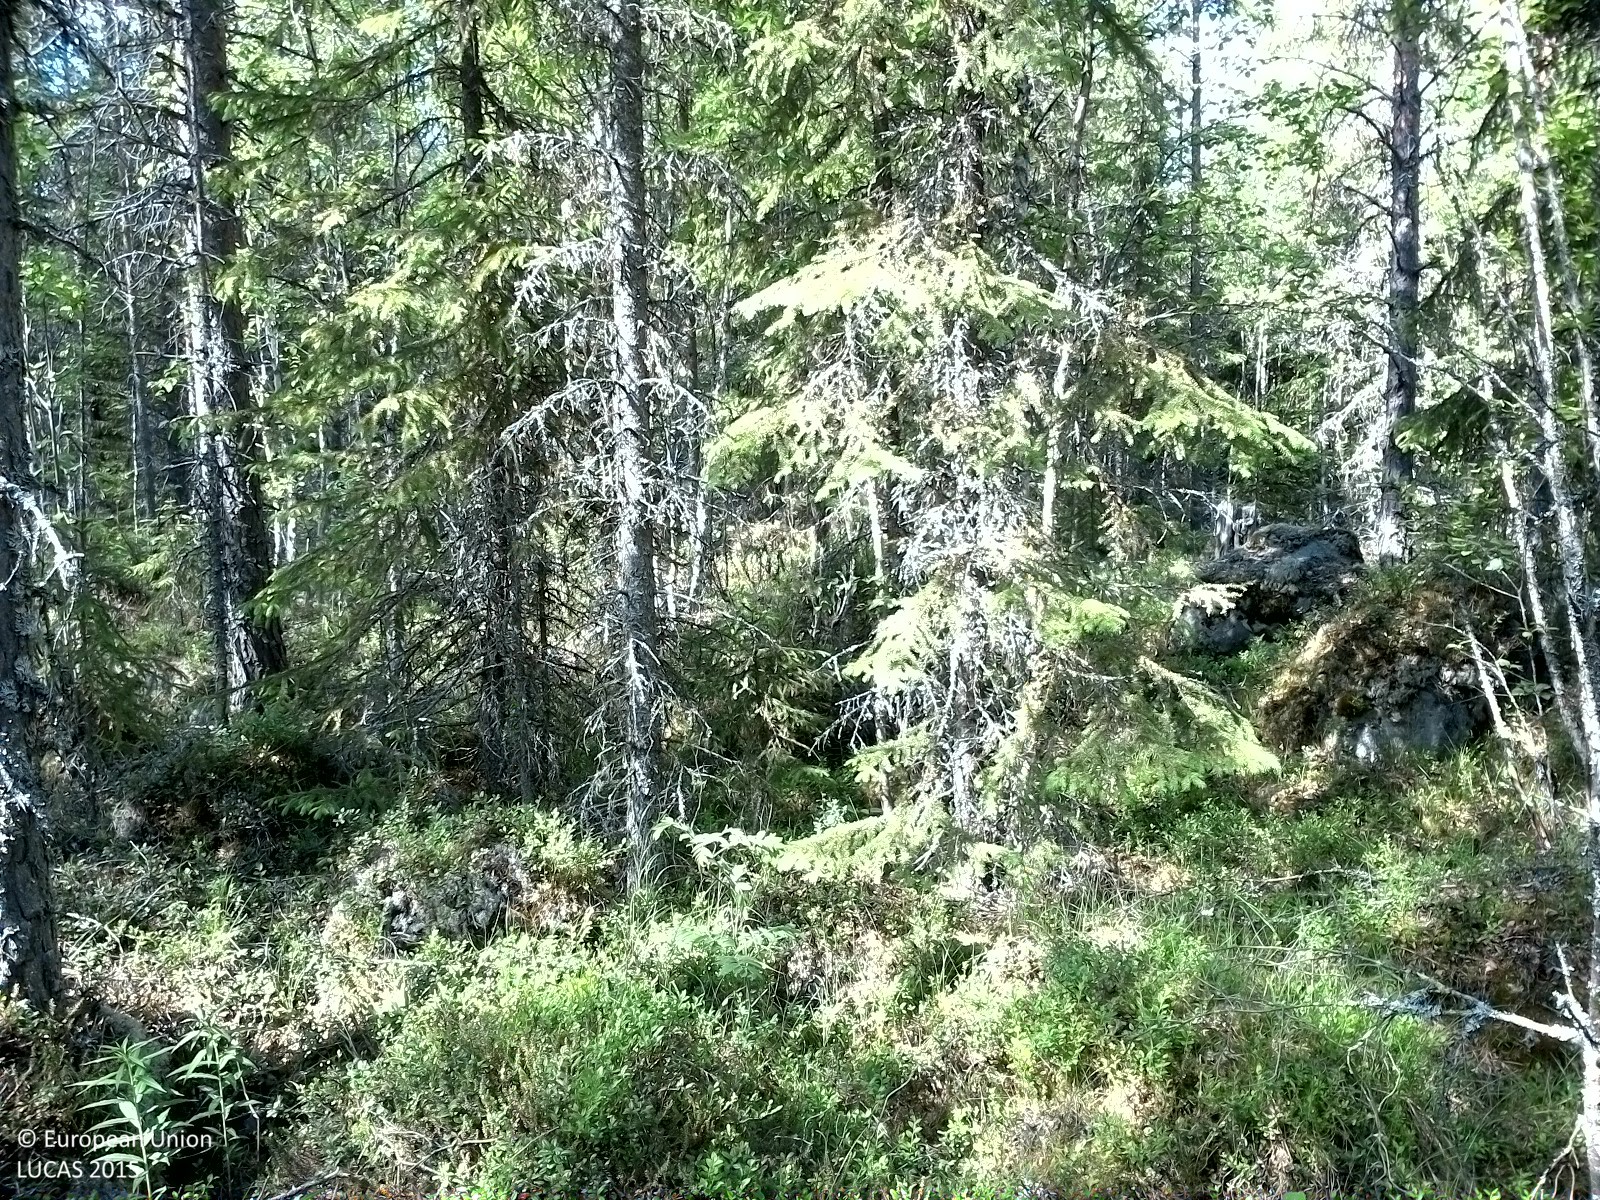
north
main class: Woodland
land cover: Other mixed woodland
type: boreal forest
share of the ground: 25 - 50 %
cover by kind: broadleaved forest trees 30 %, shrubs 30 %, coniferous forest trees 20 %, lichens and mosses 20 %
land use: Forestry
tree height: > 5 m
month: June
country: SE
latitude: 62.1682
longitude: 16.4127
